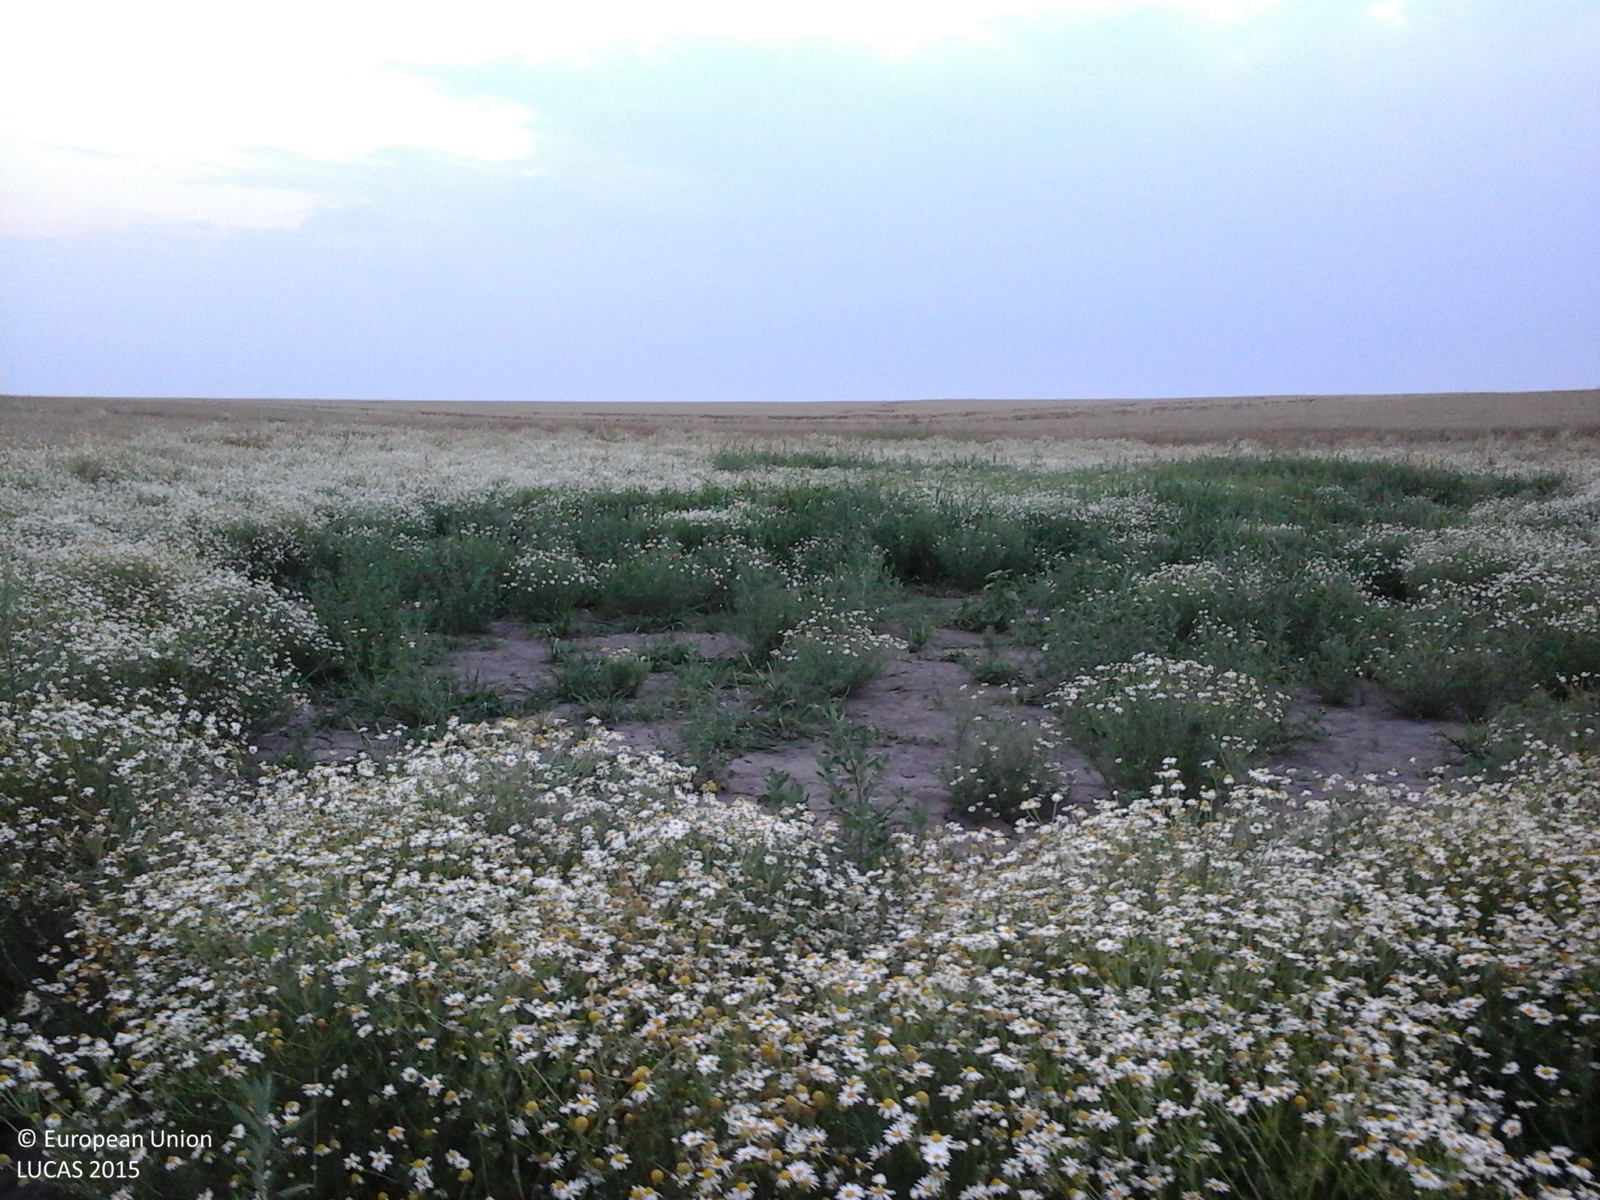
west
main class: Cropland
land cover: Other non-permanent industrial crops
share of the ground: > 75 %
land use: Agriculture (excluding fallow land and kitchen gardens)
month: July
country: RO
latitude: 43.7799
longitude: 25.2756
